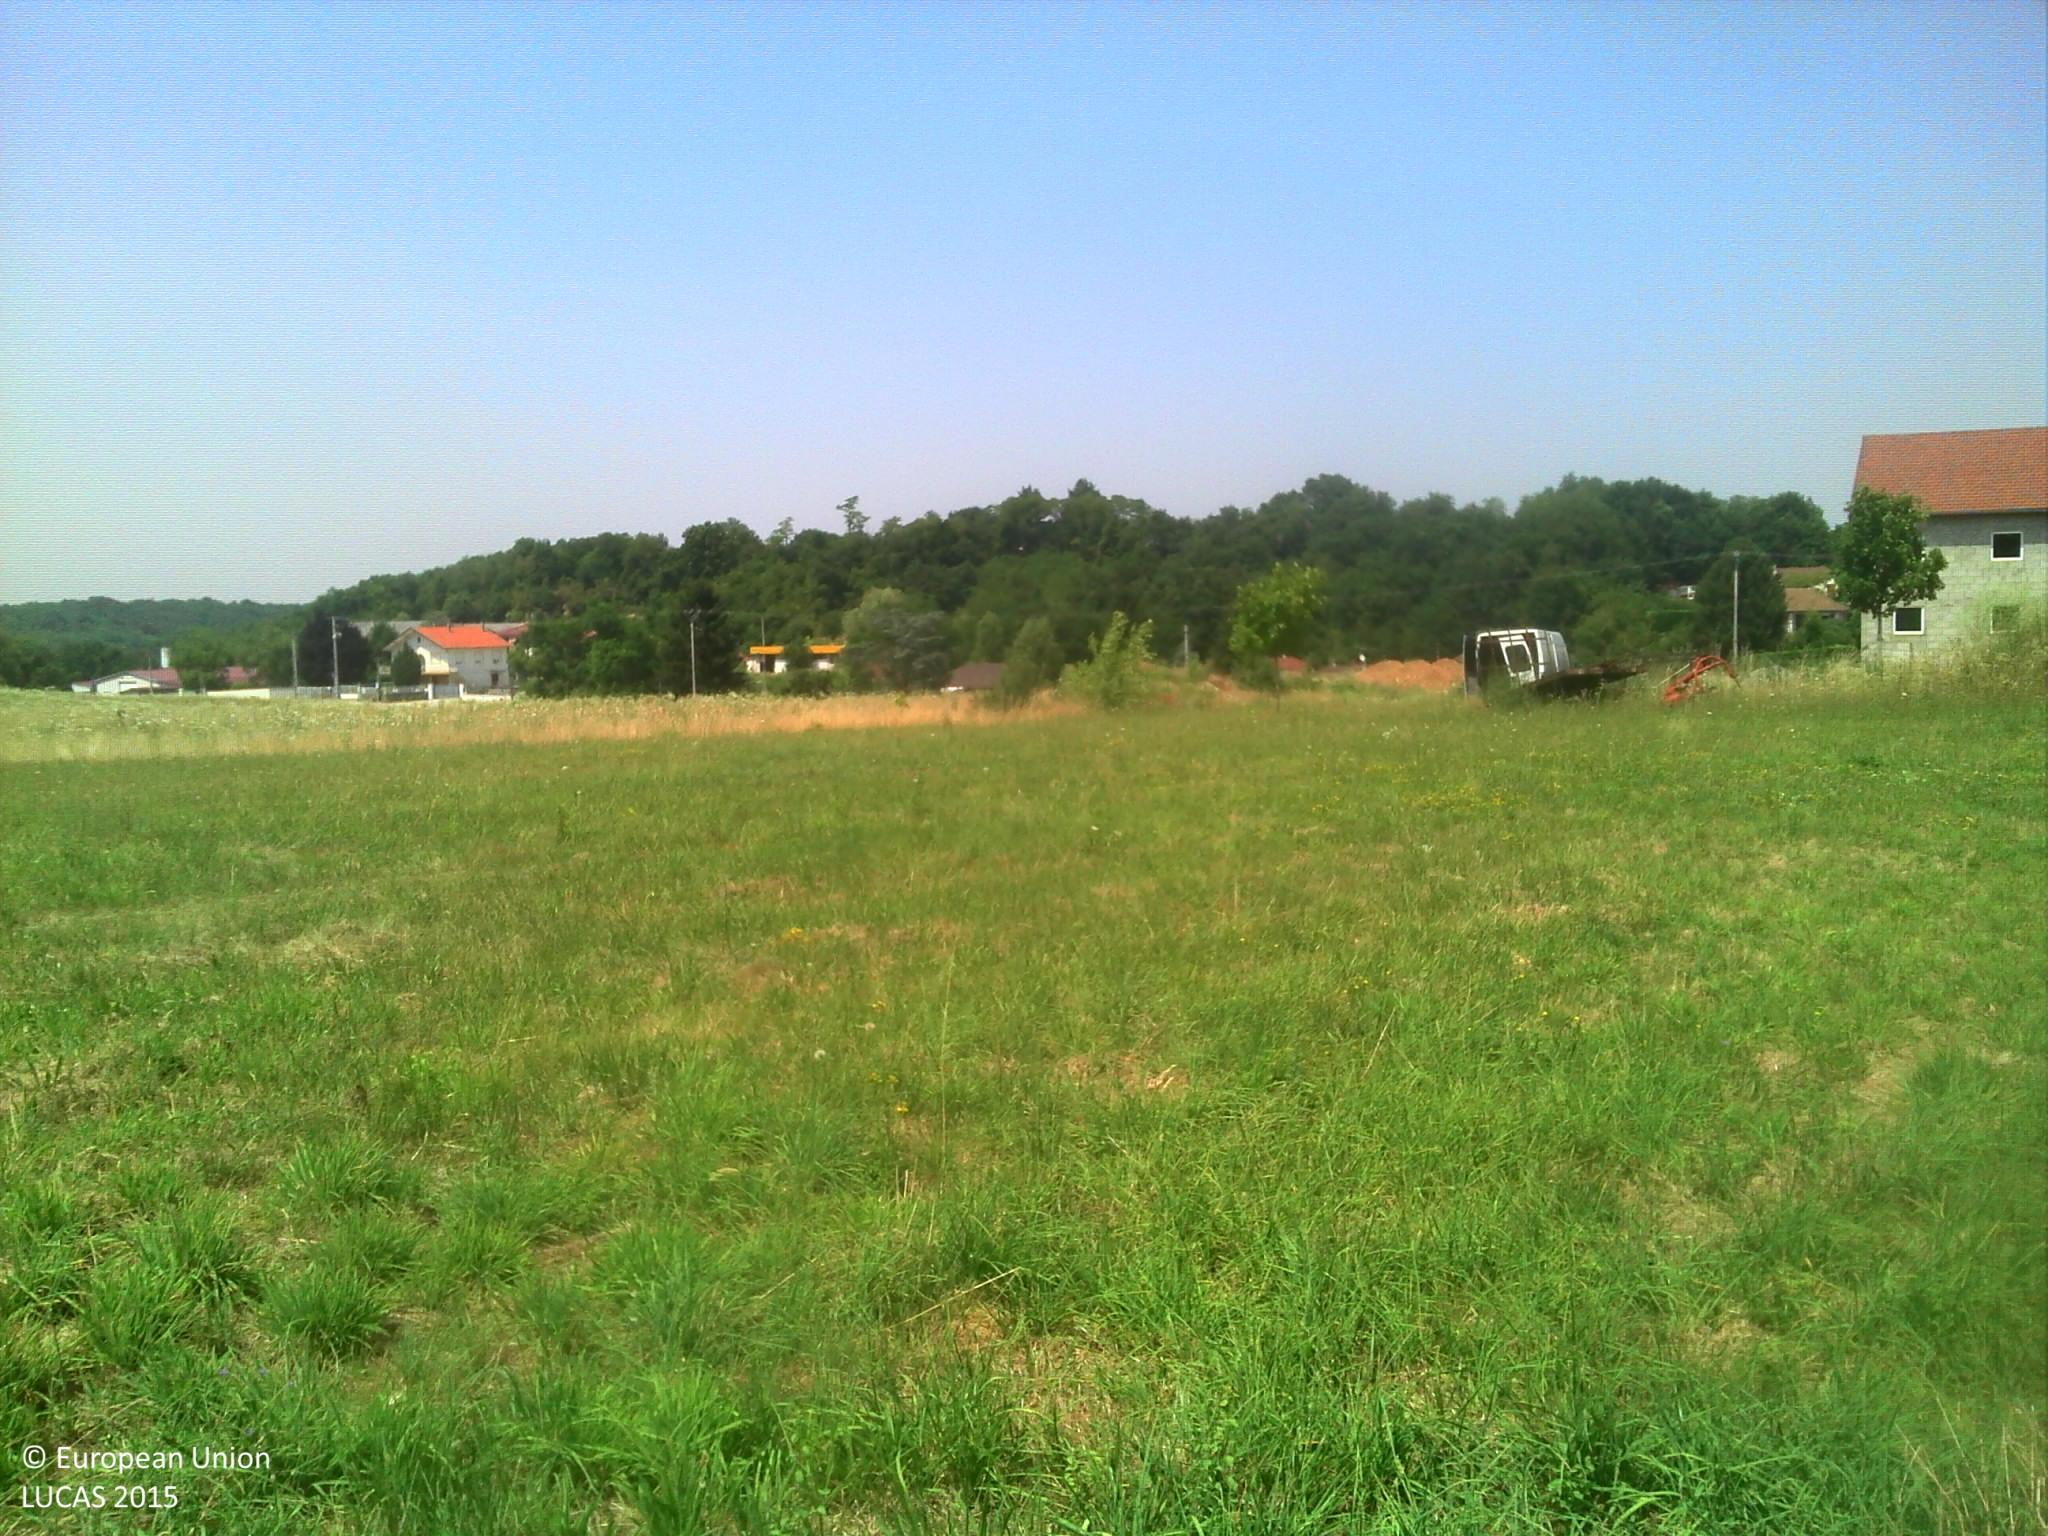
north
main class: Grassland
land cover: Grassland without tree/shrub cover
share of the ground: > 75 %
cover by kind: herbaceous plants 100 %
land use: Agriculture (excluding fallow land and kitchen gardens)
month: July
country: FR
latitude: 45.7543
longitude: 5.1573
